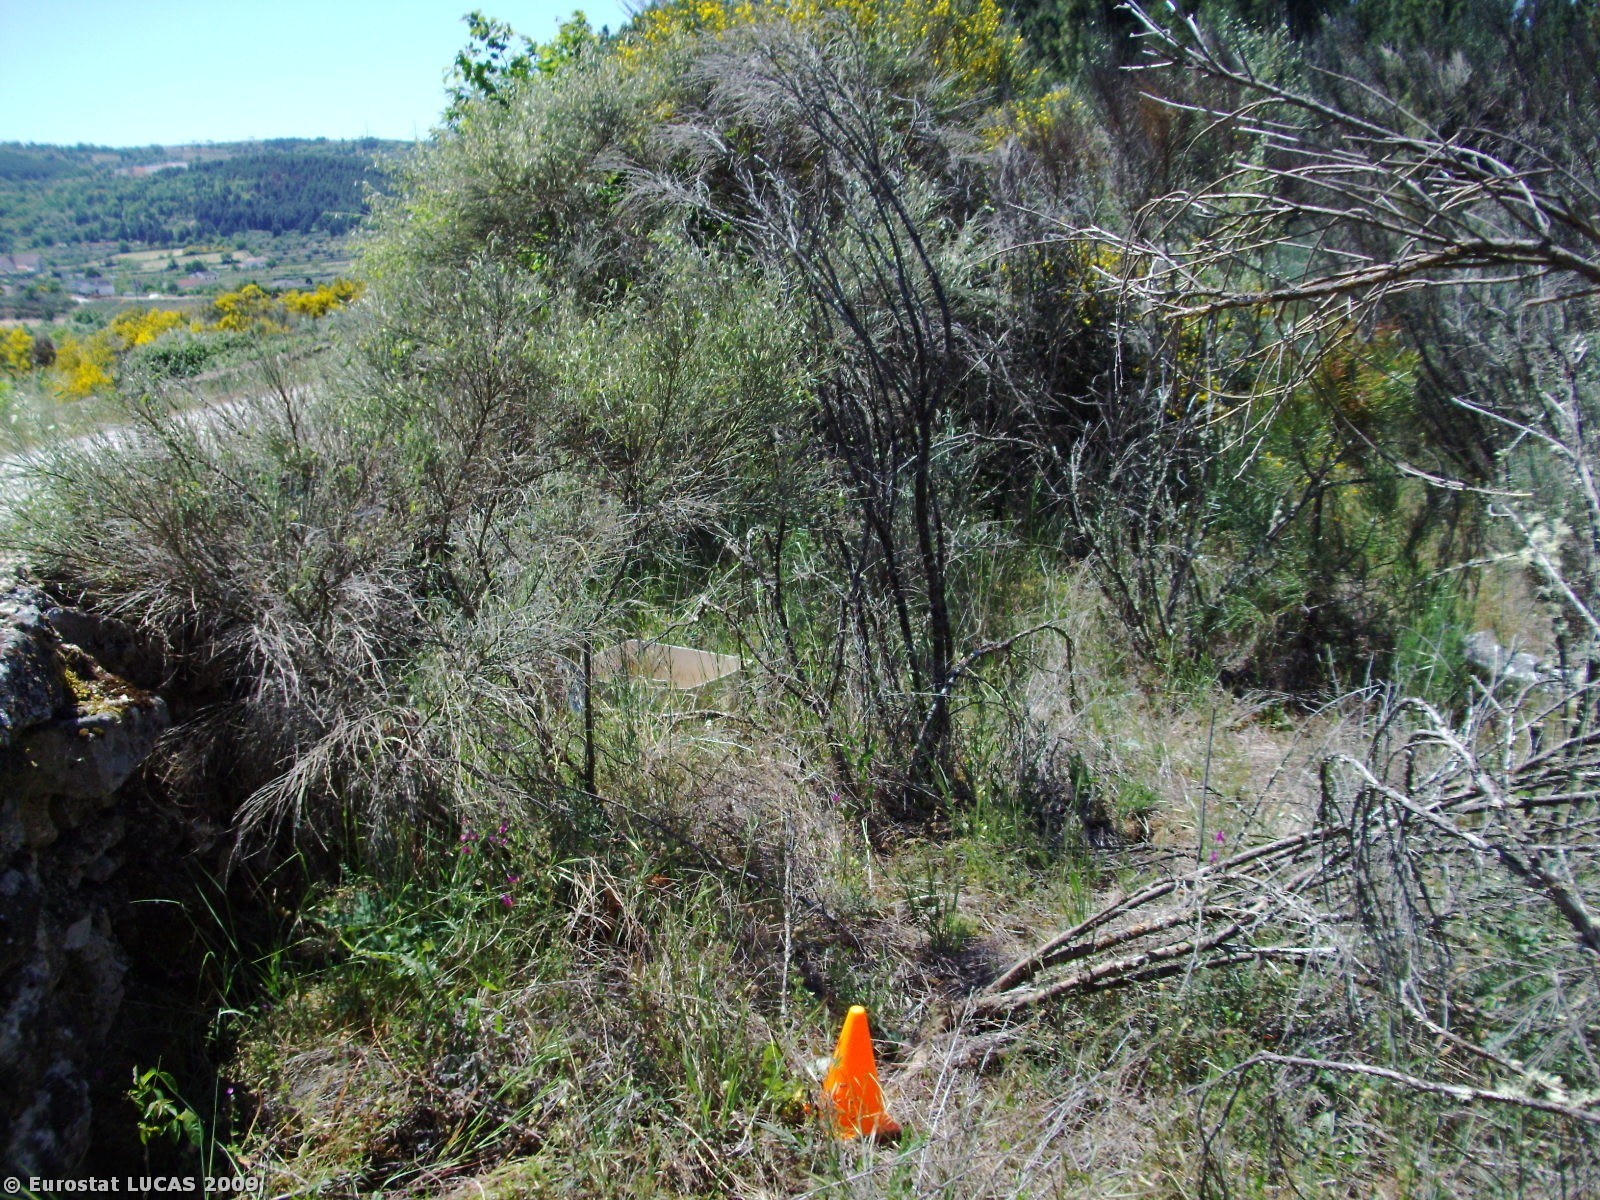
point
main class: Shrubland
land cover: Shrubland without tree cover
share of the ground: > 75 %
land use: Unused
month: May
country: PT
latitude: 40.9733
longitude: -7.5780
